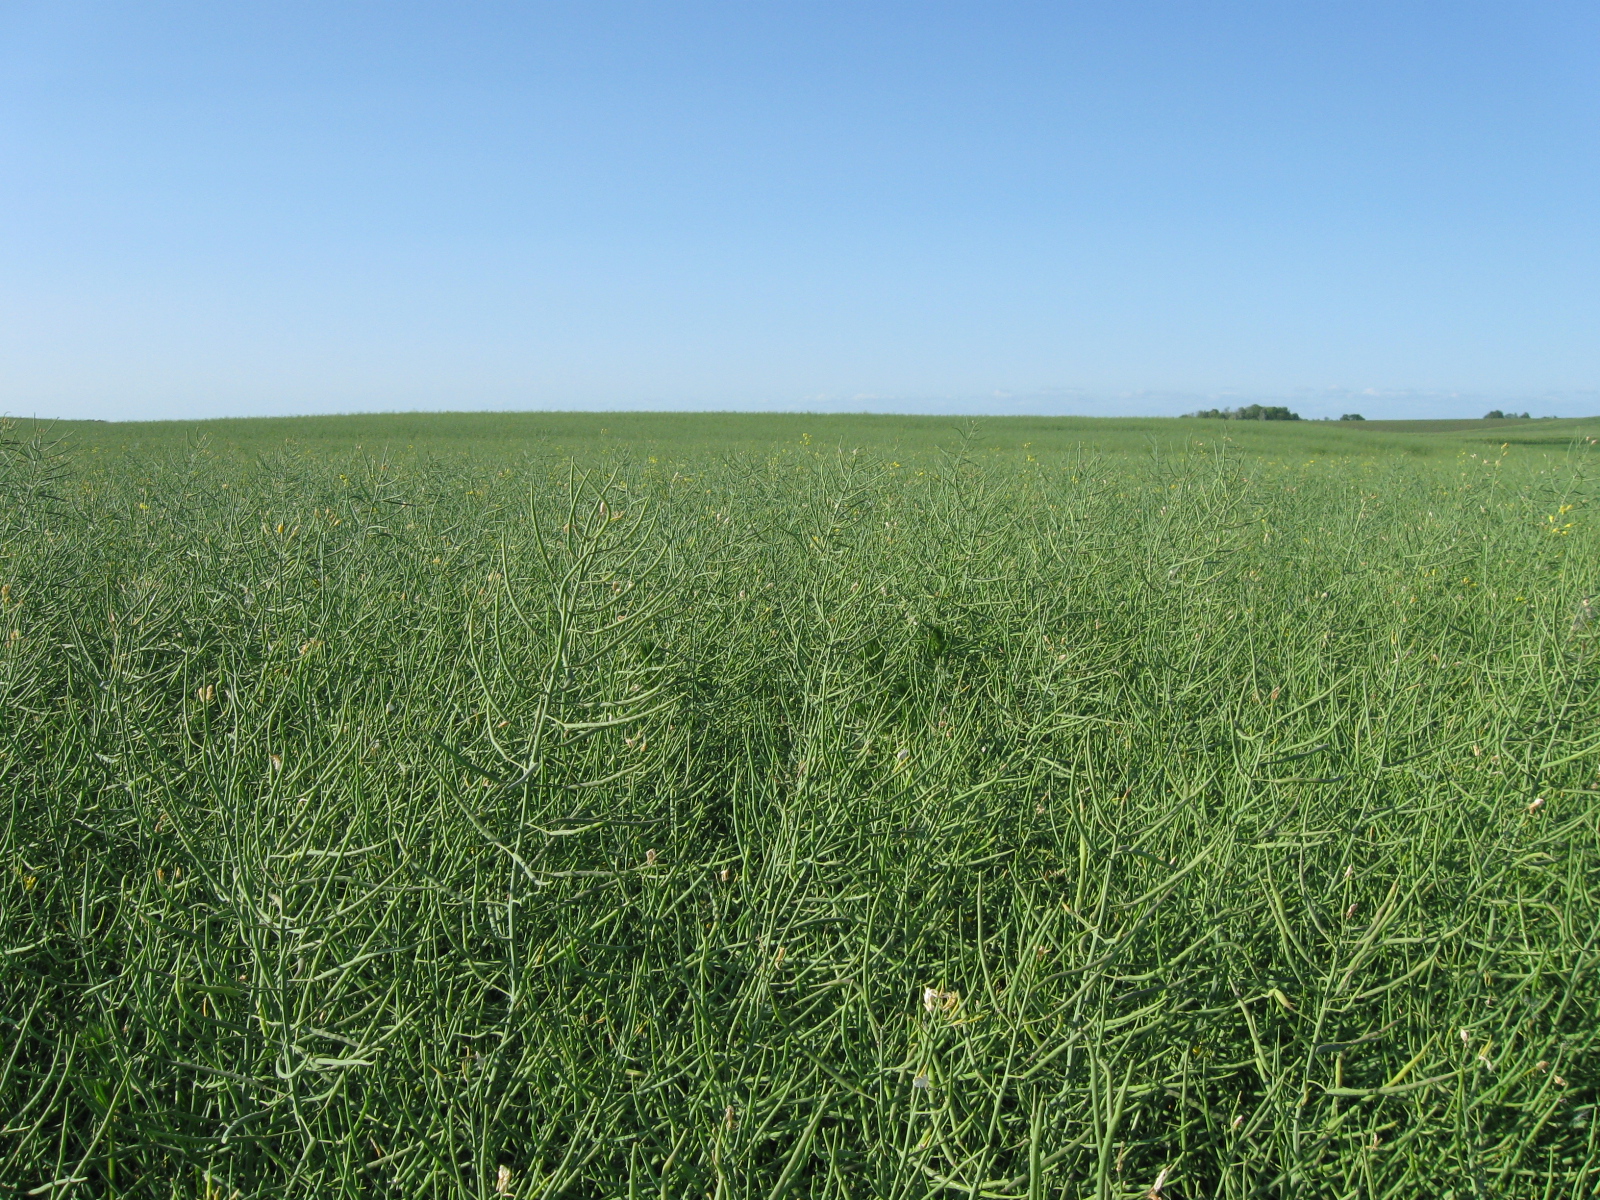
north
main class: Cropland
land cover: Rape and turnip rape
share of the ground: > 75 %
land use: Agriculture (excluding fallow land and kitchen gardens)
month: June
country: LT
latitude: 54.4333
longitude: 23.7930
